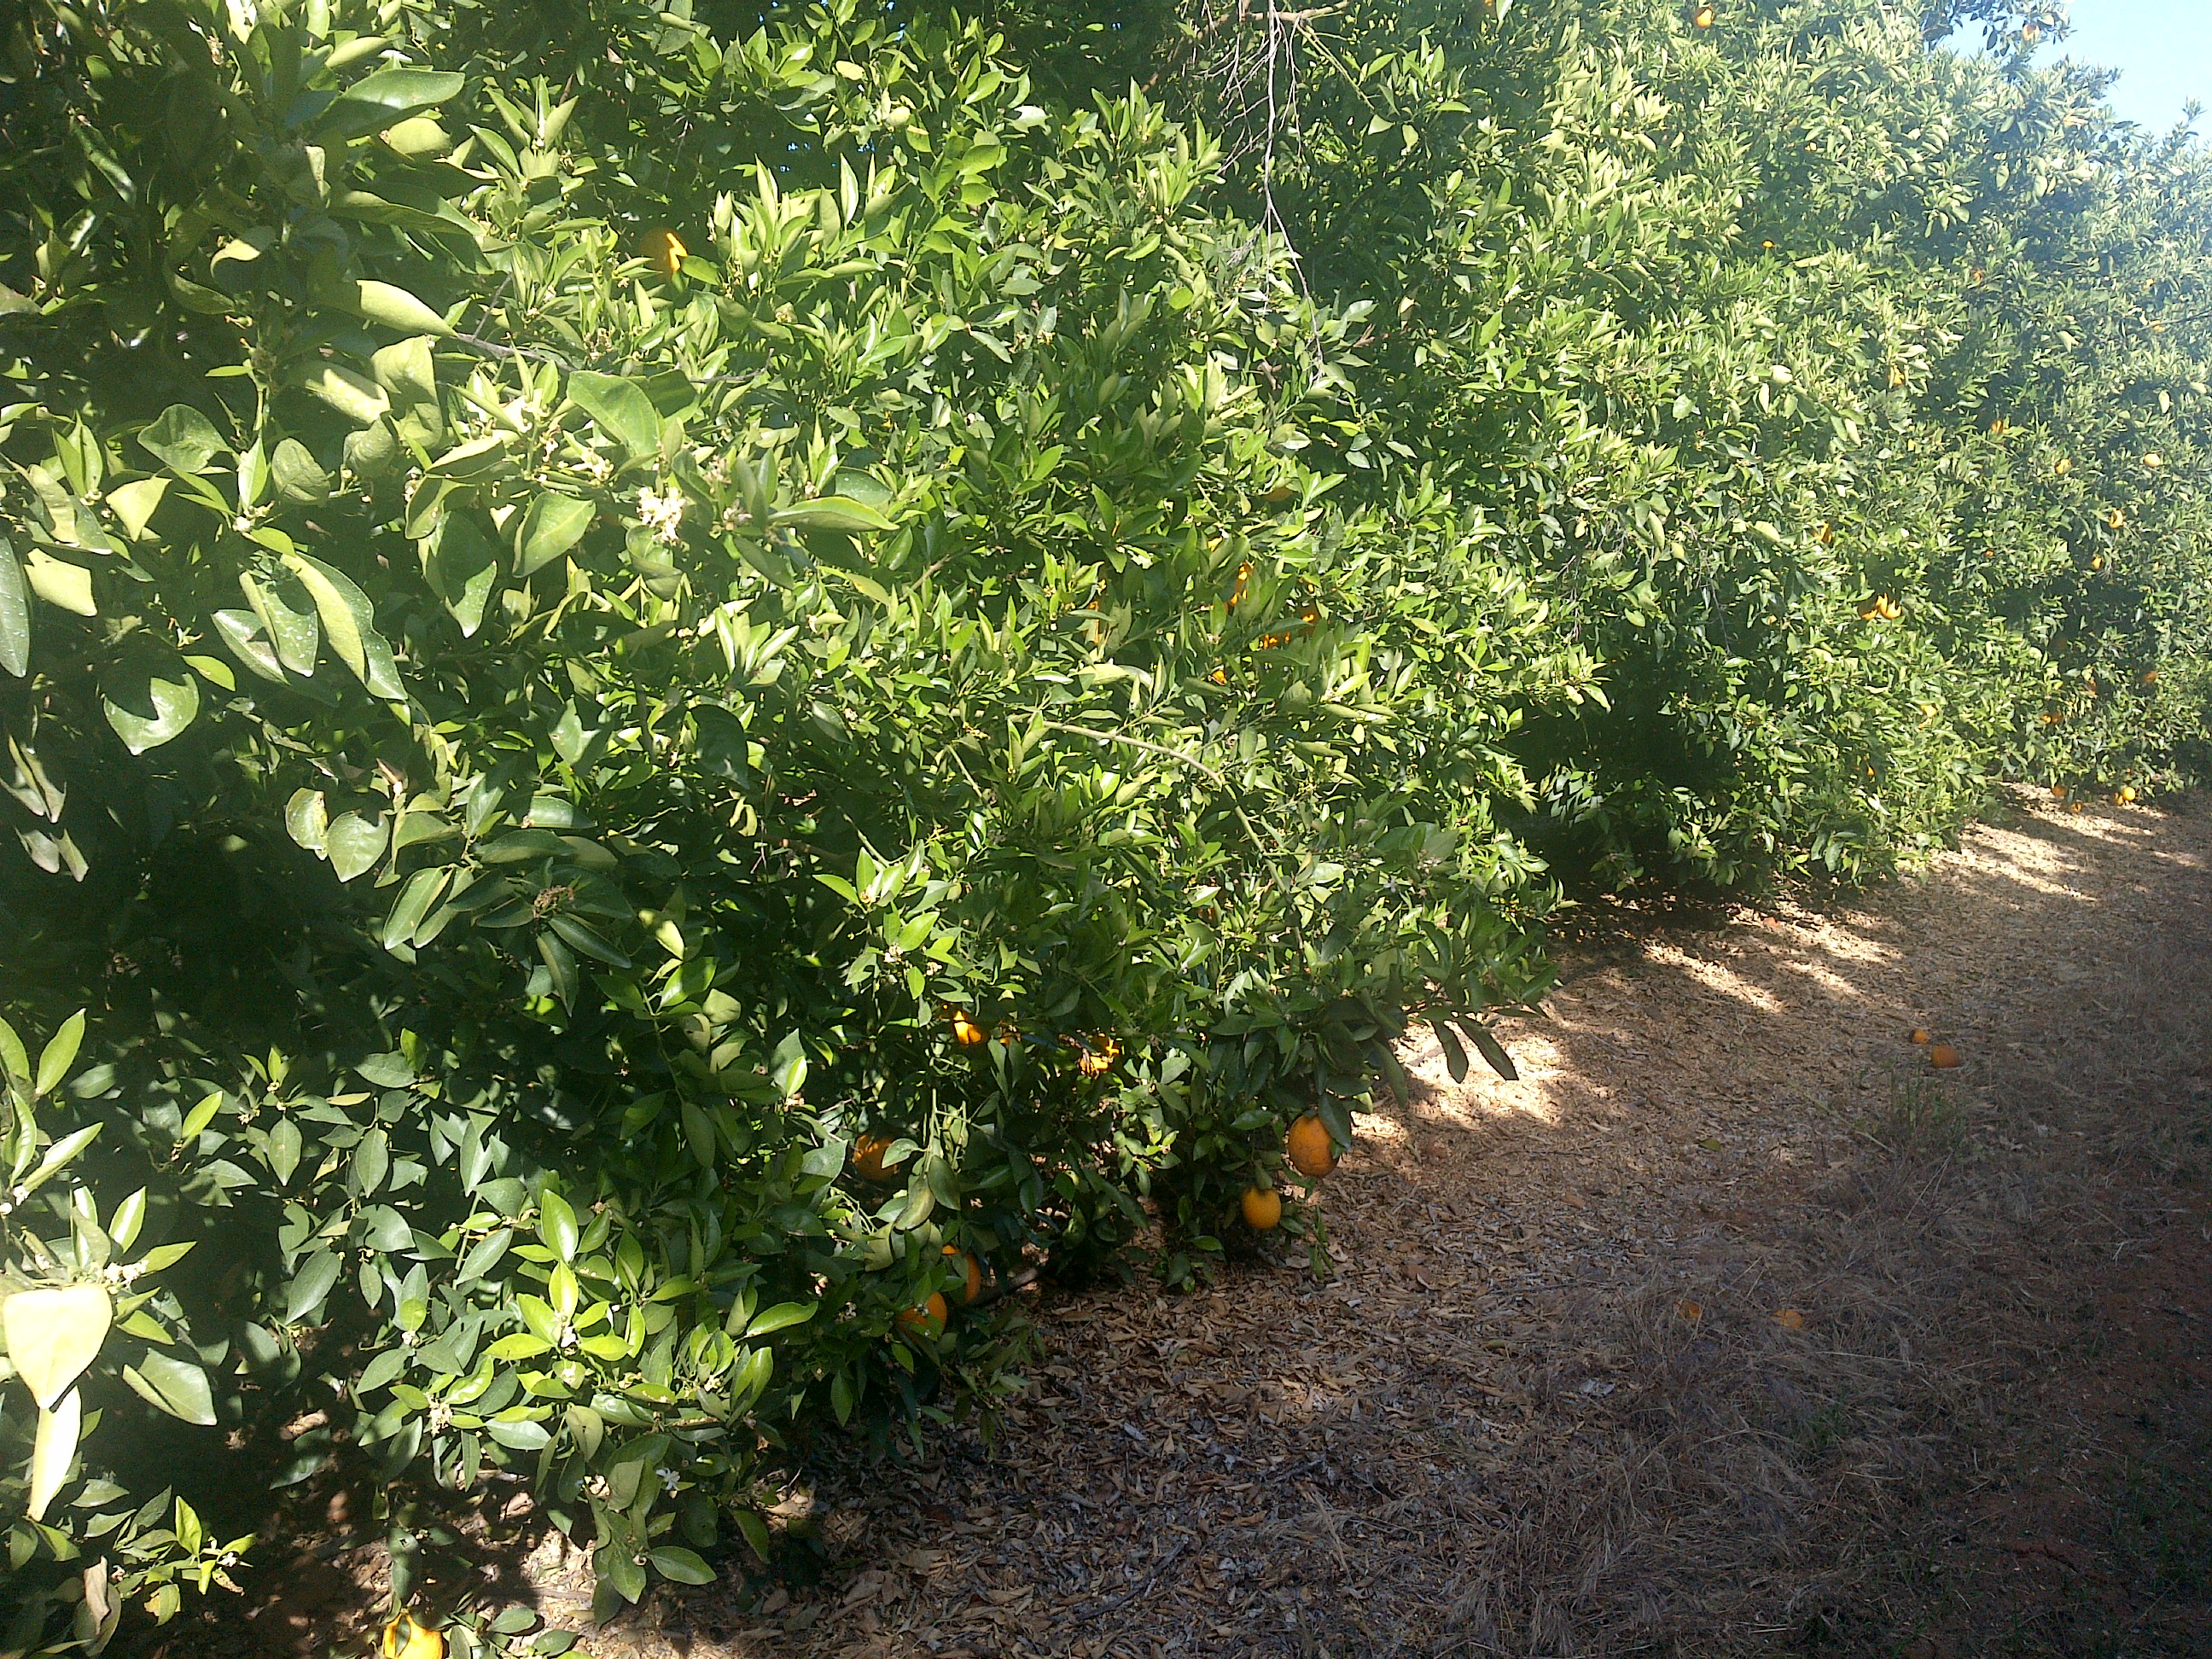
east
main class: Cropland
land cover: Oranges
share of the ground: > 75 %
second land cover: Spontaneously vegetated surfaces
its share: 25 - 50 %
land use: Agriculture (excluding fallow land and kitchen gardens)
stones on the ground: < 10 %
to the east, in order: Oranges; Spontaneously vegetated surfaces; Grass margins; Paved roads, cycling and walking lanes; Grassland with sparse tree/shrub cover; Fences; Single bushes/trees; Oranges
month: May
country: ES
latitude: 37.7880
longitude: -5.2007
